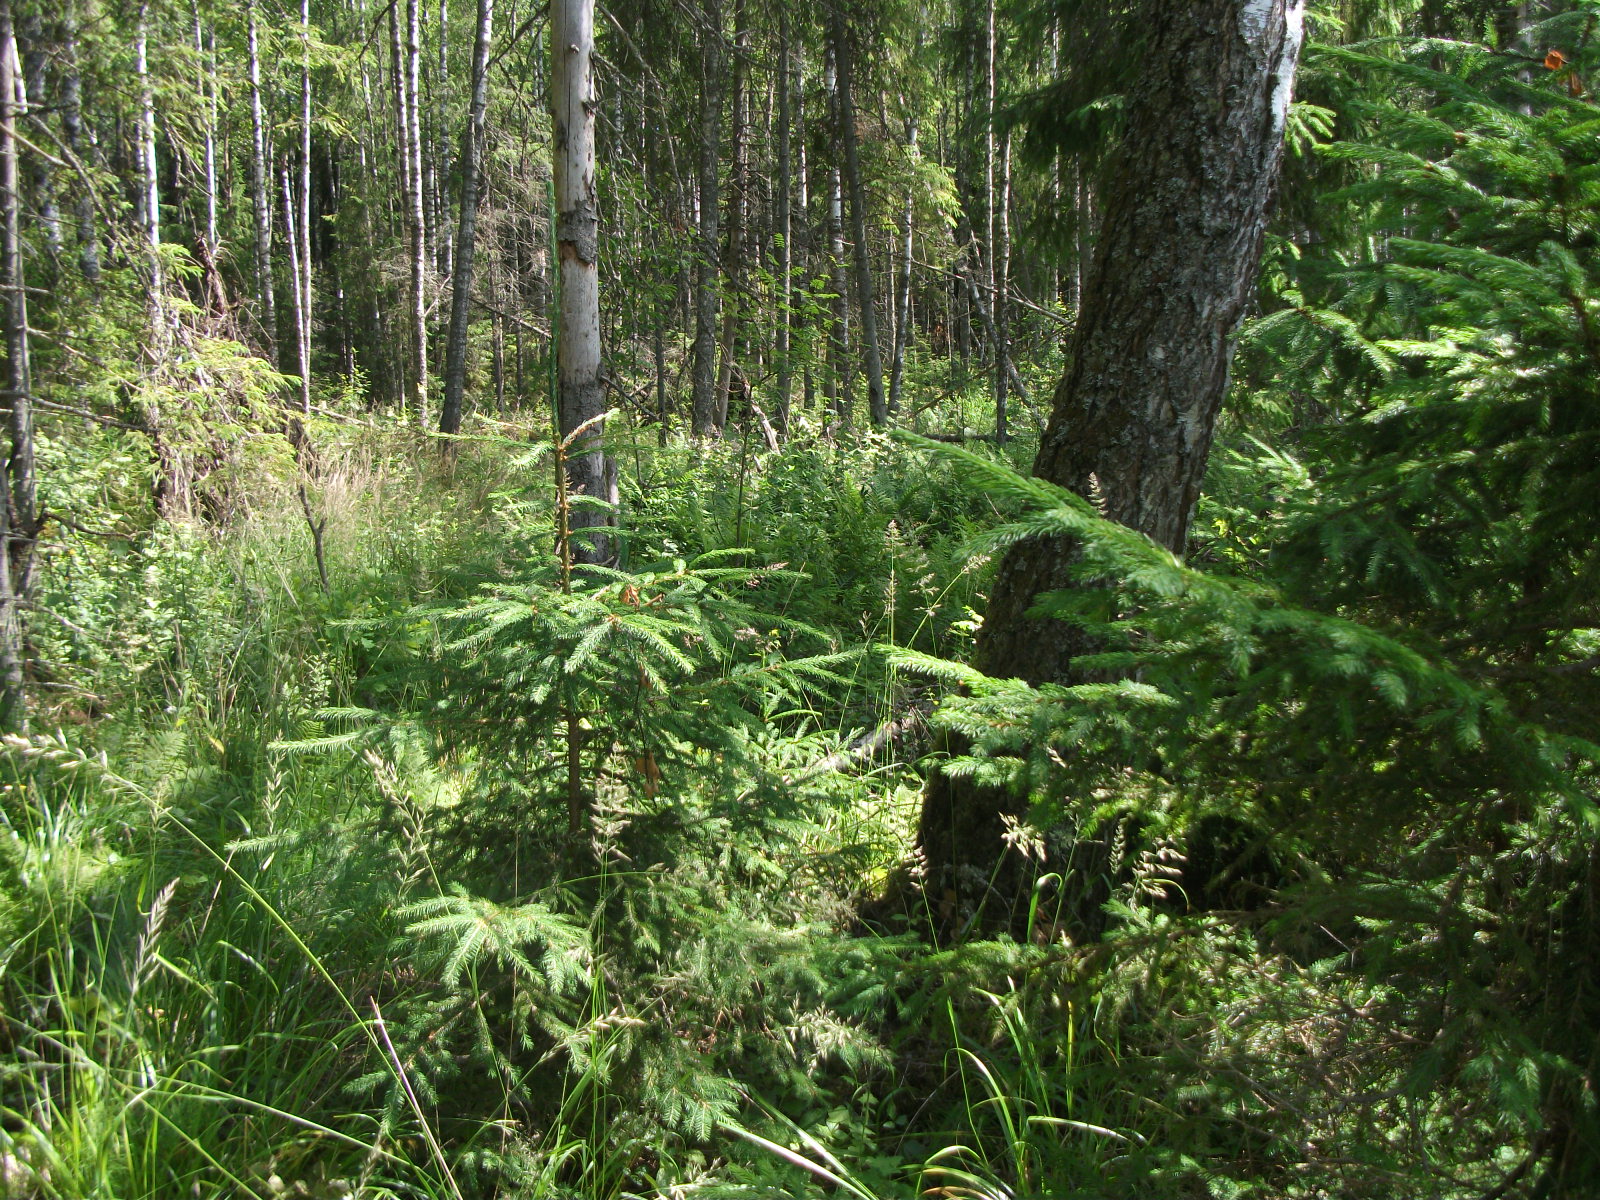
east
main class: Woodland
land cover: Spruce dominated mixed woodland
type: hemiboreal forest and nemoral coniferous forest and mixed broadleaved-coniferous forest
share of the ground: > 75 %
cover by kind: coniferous forest trees 65 %, broadleaved forest trees 25 %, herbaceous plants 10 %
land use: Forestry
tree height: > 5 m
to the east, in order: Spruce dominated mixed woodland; Other mixed woodland; Pine dominated coniferous woodland; Other coniferous woodland
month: July
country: LV
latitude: 57.0684
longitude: 26.2854
